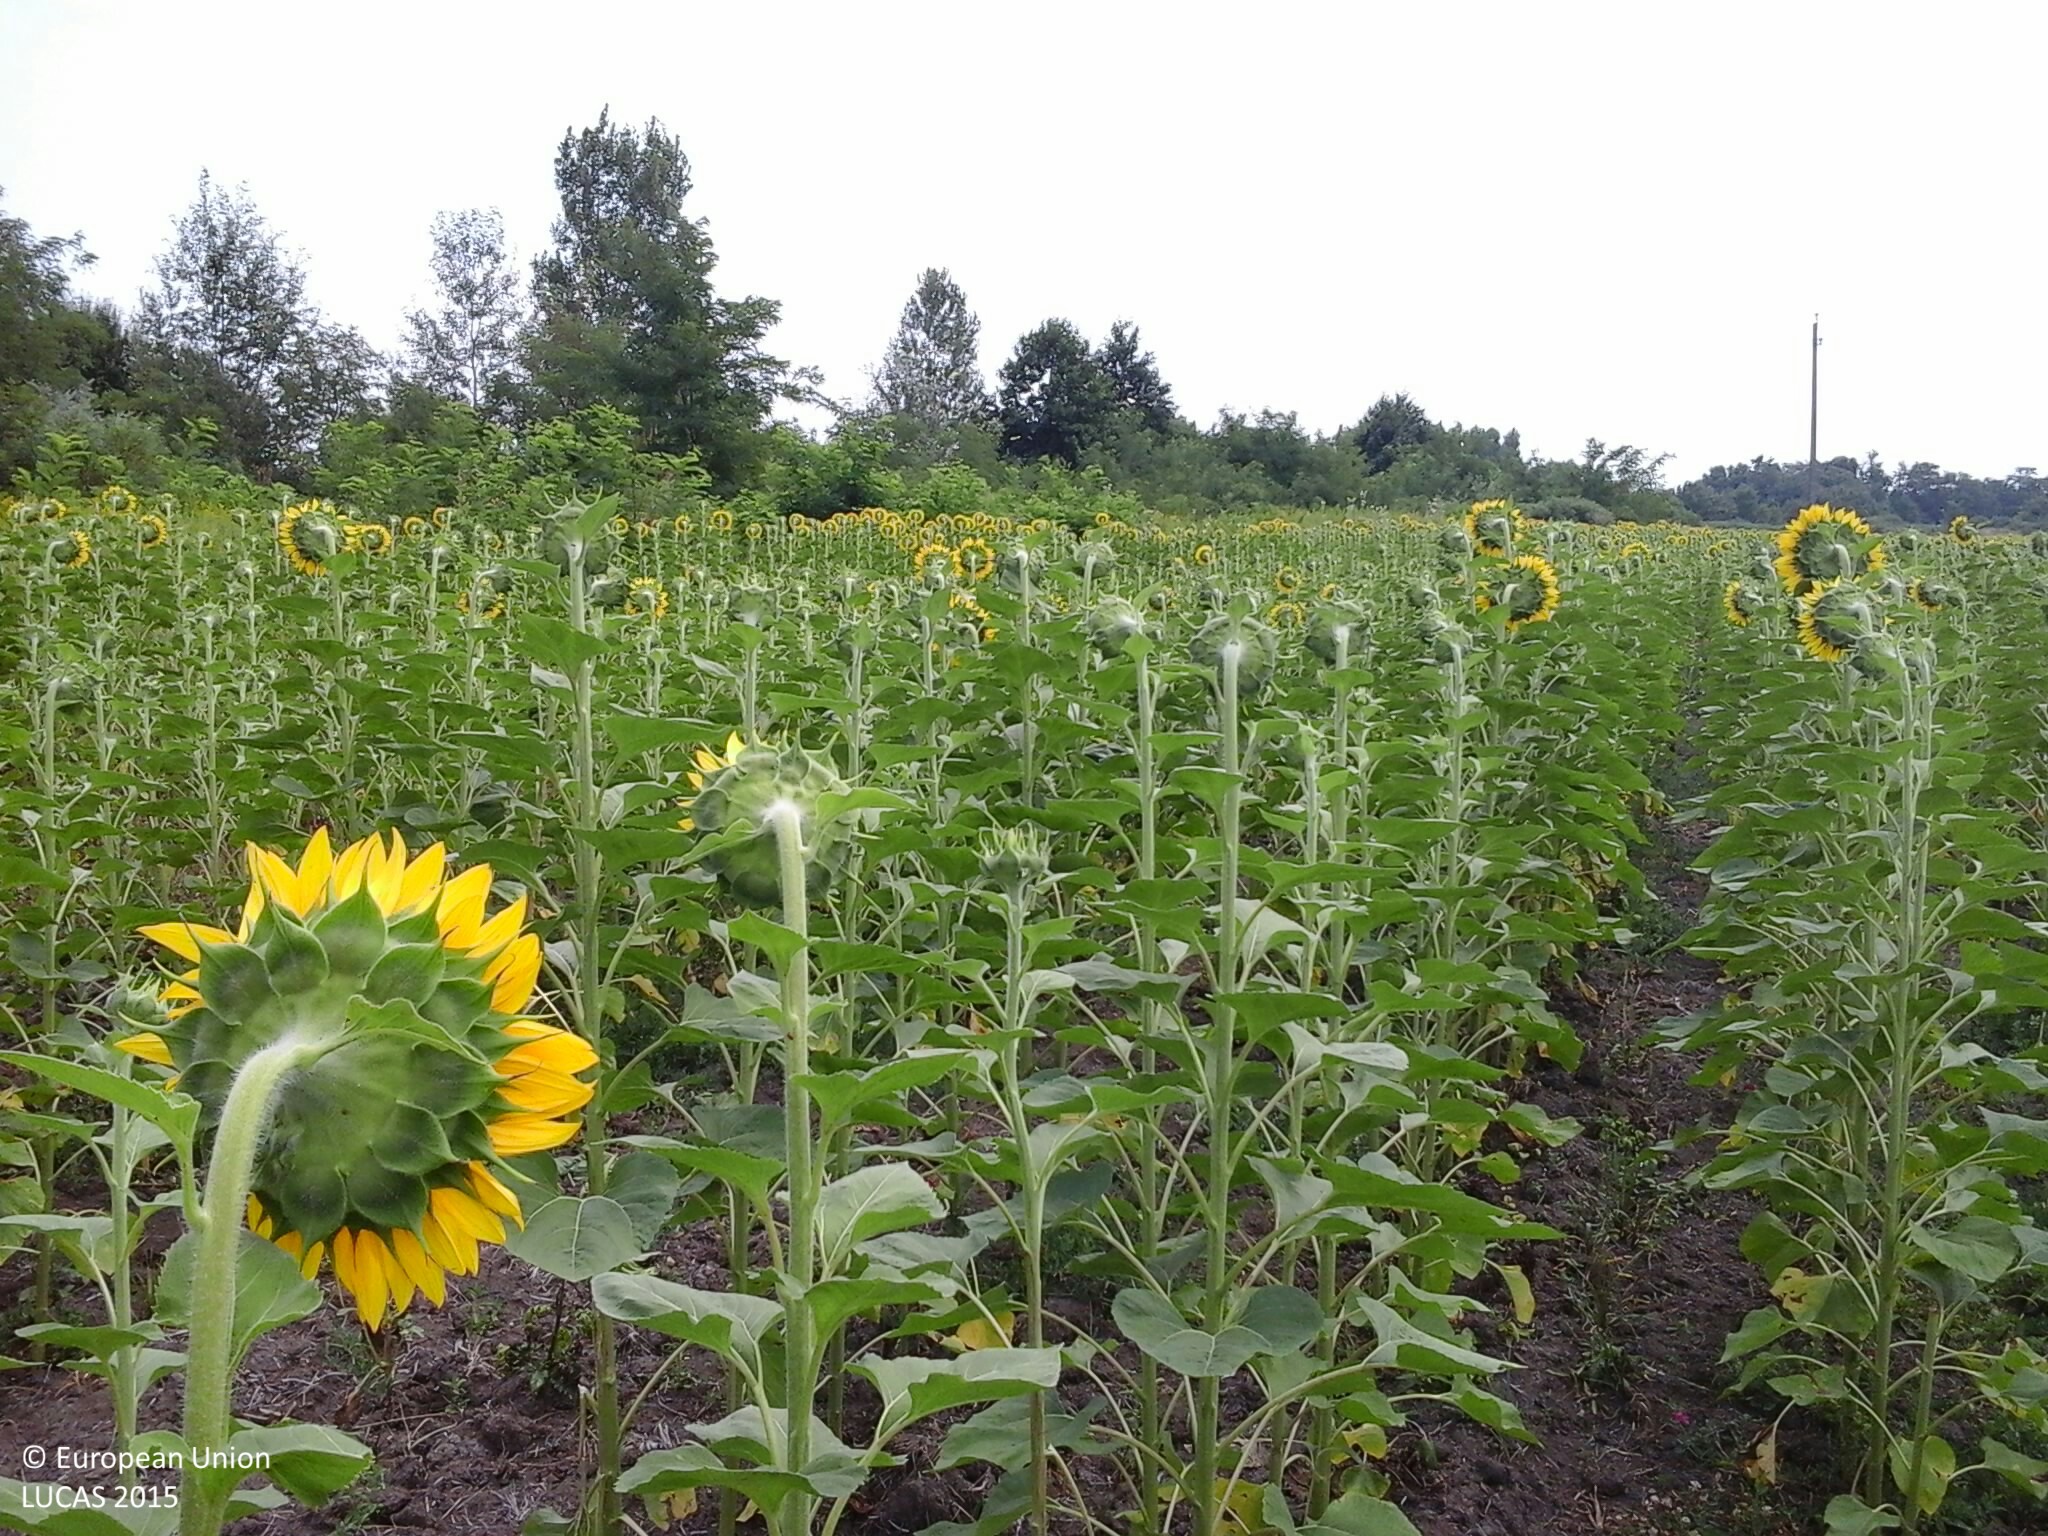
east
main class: Cropland
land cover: Sunflower
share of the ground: > 75 %
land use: Agriculture (excluding fallow land and kitchen gardens)
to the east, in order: Sunflower; Grassland with sparse tree/shrub cover; Shrubland with sparse tree cover; Inland fresh running water; Shrubland with sparse tree cover; Arable land (only in case pi); Electric lines; Arable land (only in case pi)
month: July
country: HU
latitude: 47.7754
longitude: 21.0480
